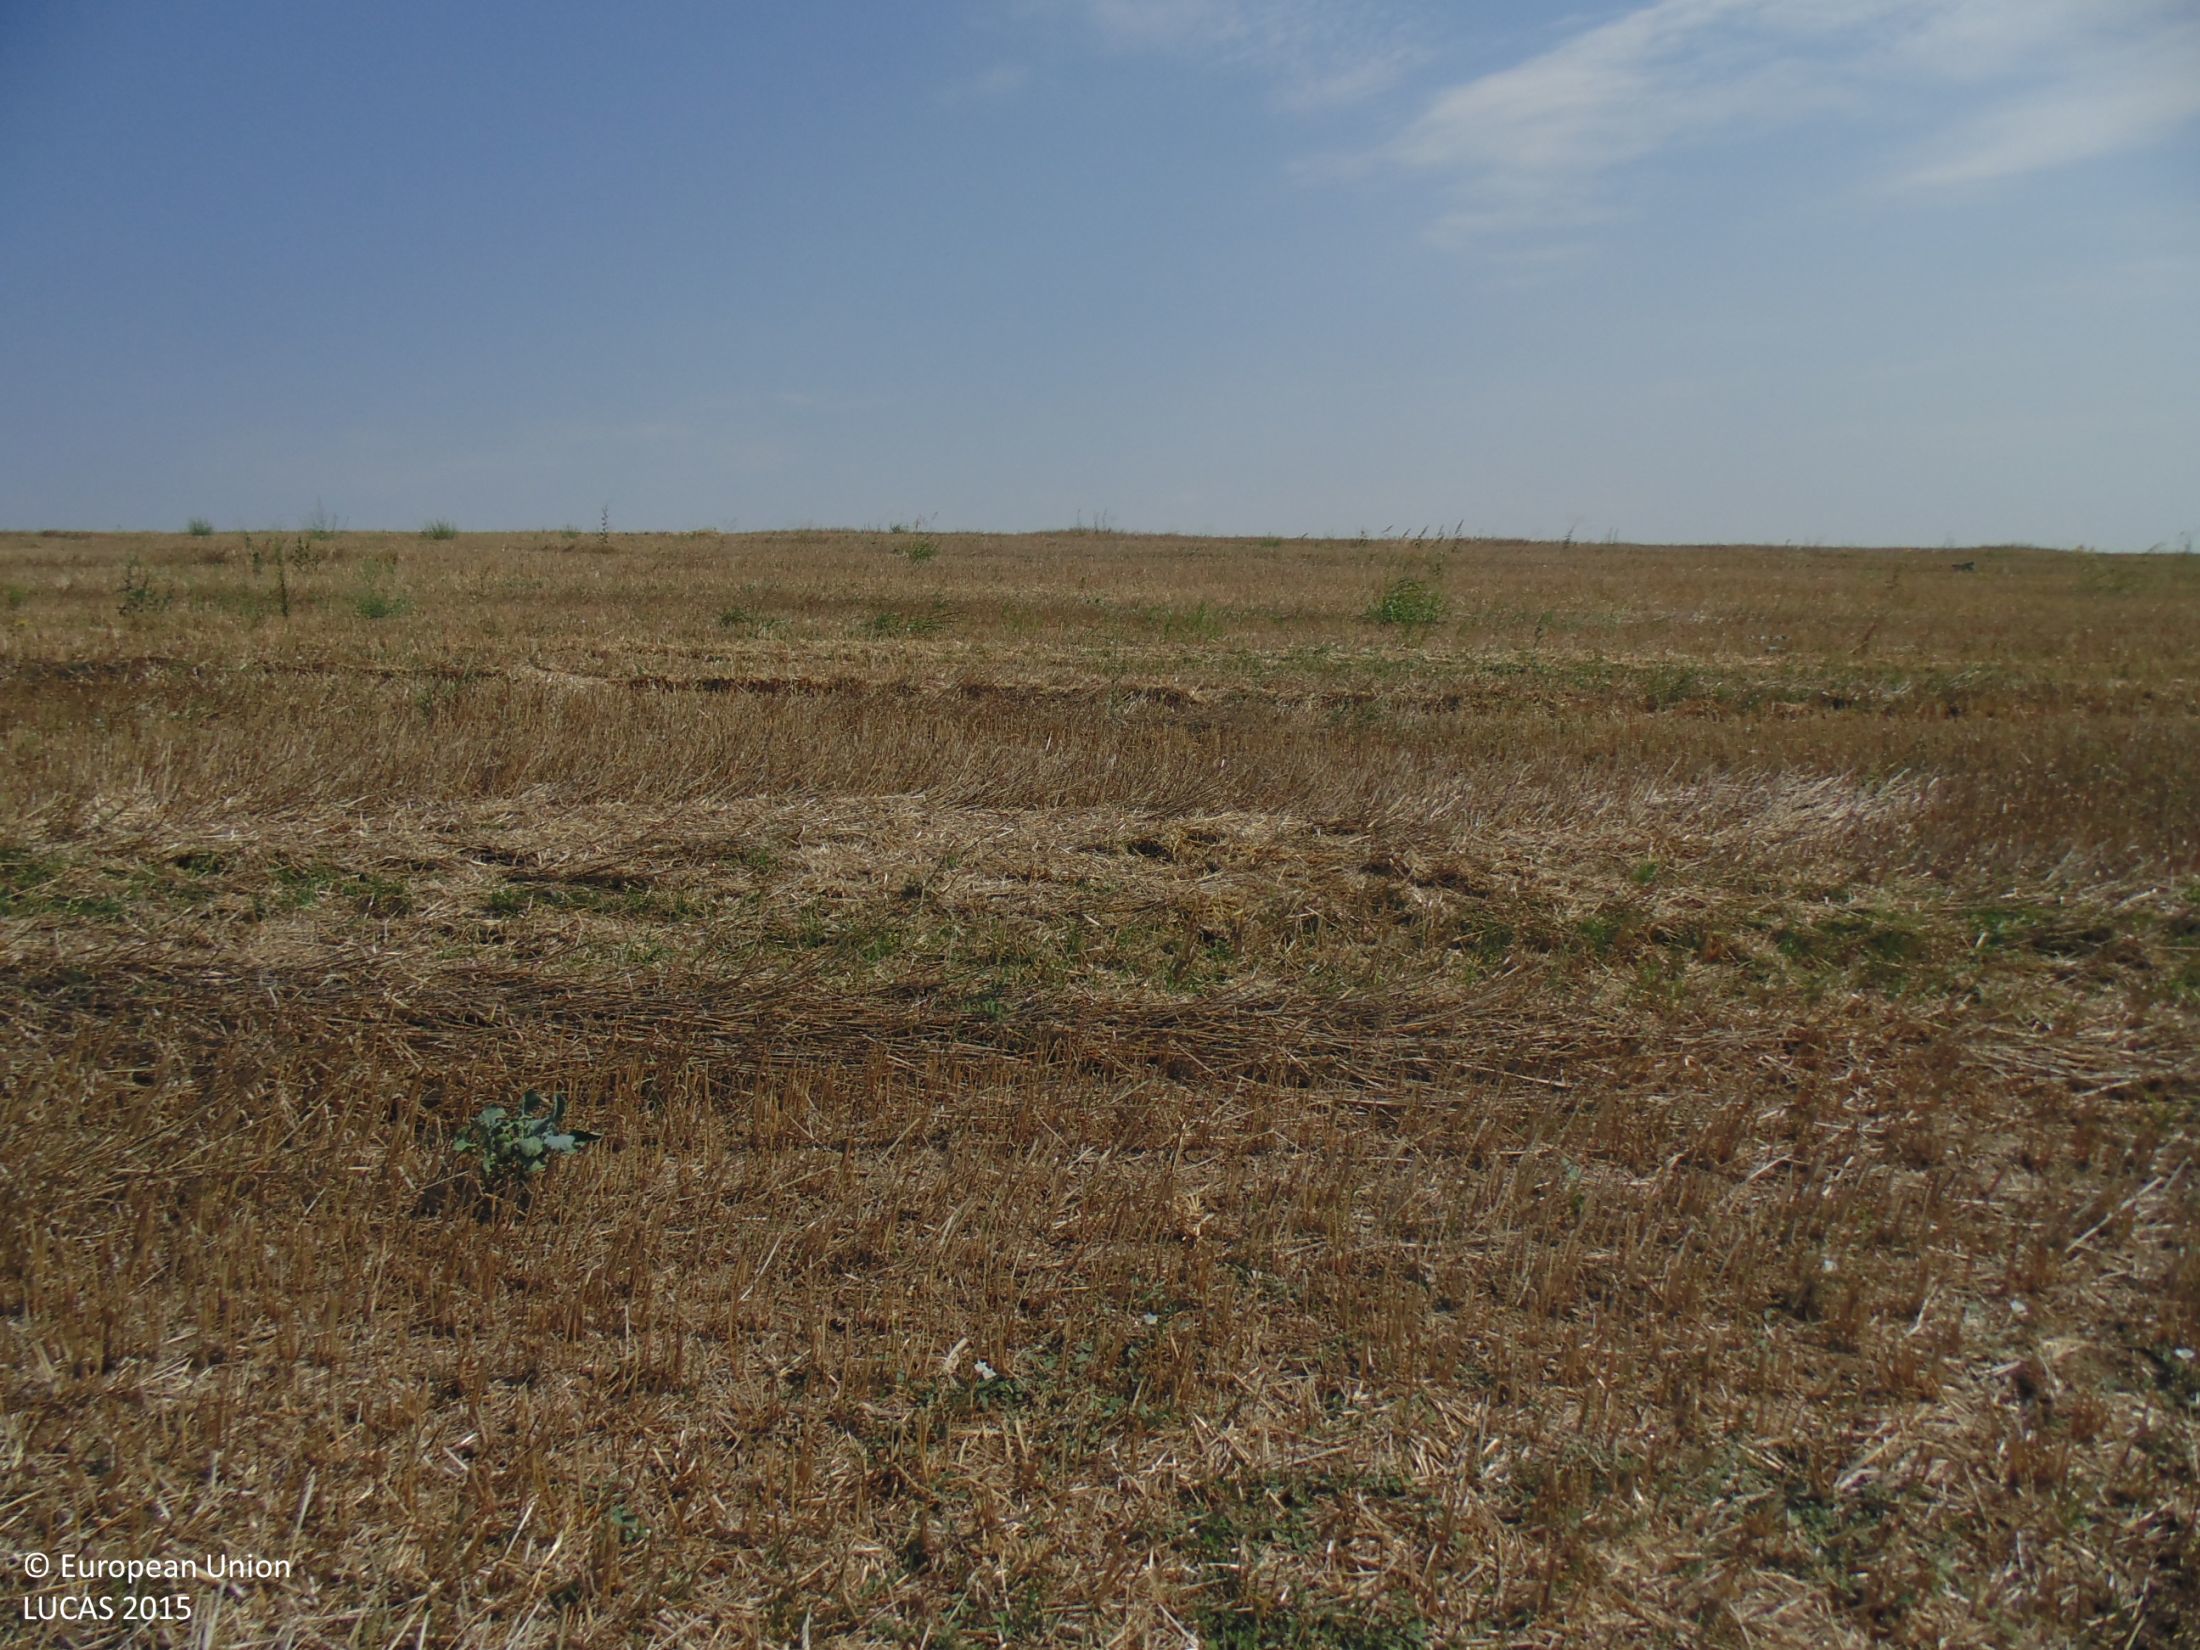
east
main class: Cropland
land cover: Common wheat
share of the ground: 10 - 25 %
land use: Agriculture (excluding fallow land and kitchen gardens)
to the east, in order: Common wheat
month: August
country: BG
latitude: 44.0145
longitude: 27.2571
